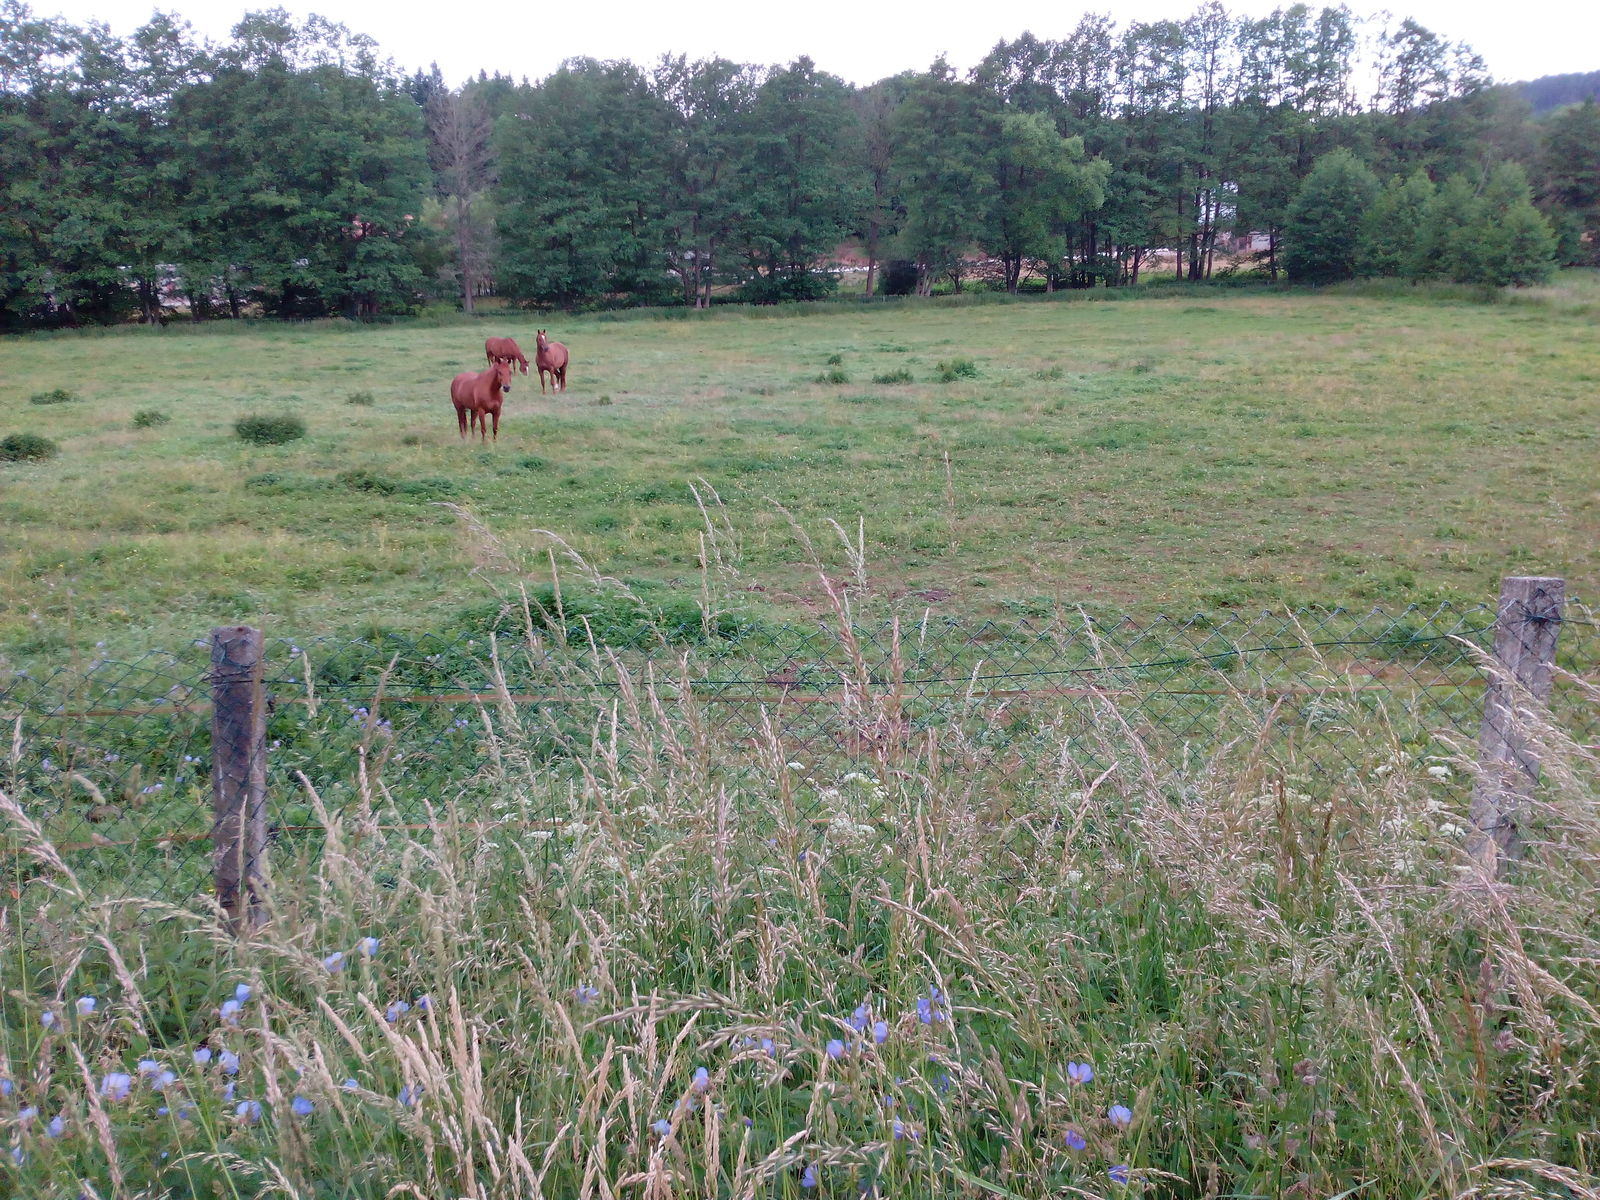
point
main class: Grassland
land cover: Grassland without tree/shrub cover
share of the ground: > 75 %
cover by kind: herbaceous plants 100 %
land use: Agriculture (excluding fallow land and kitchen gardens)
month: June
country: DE
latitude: 50.5061
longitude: 10.6343
